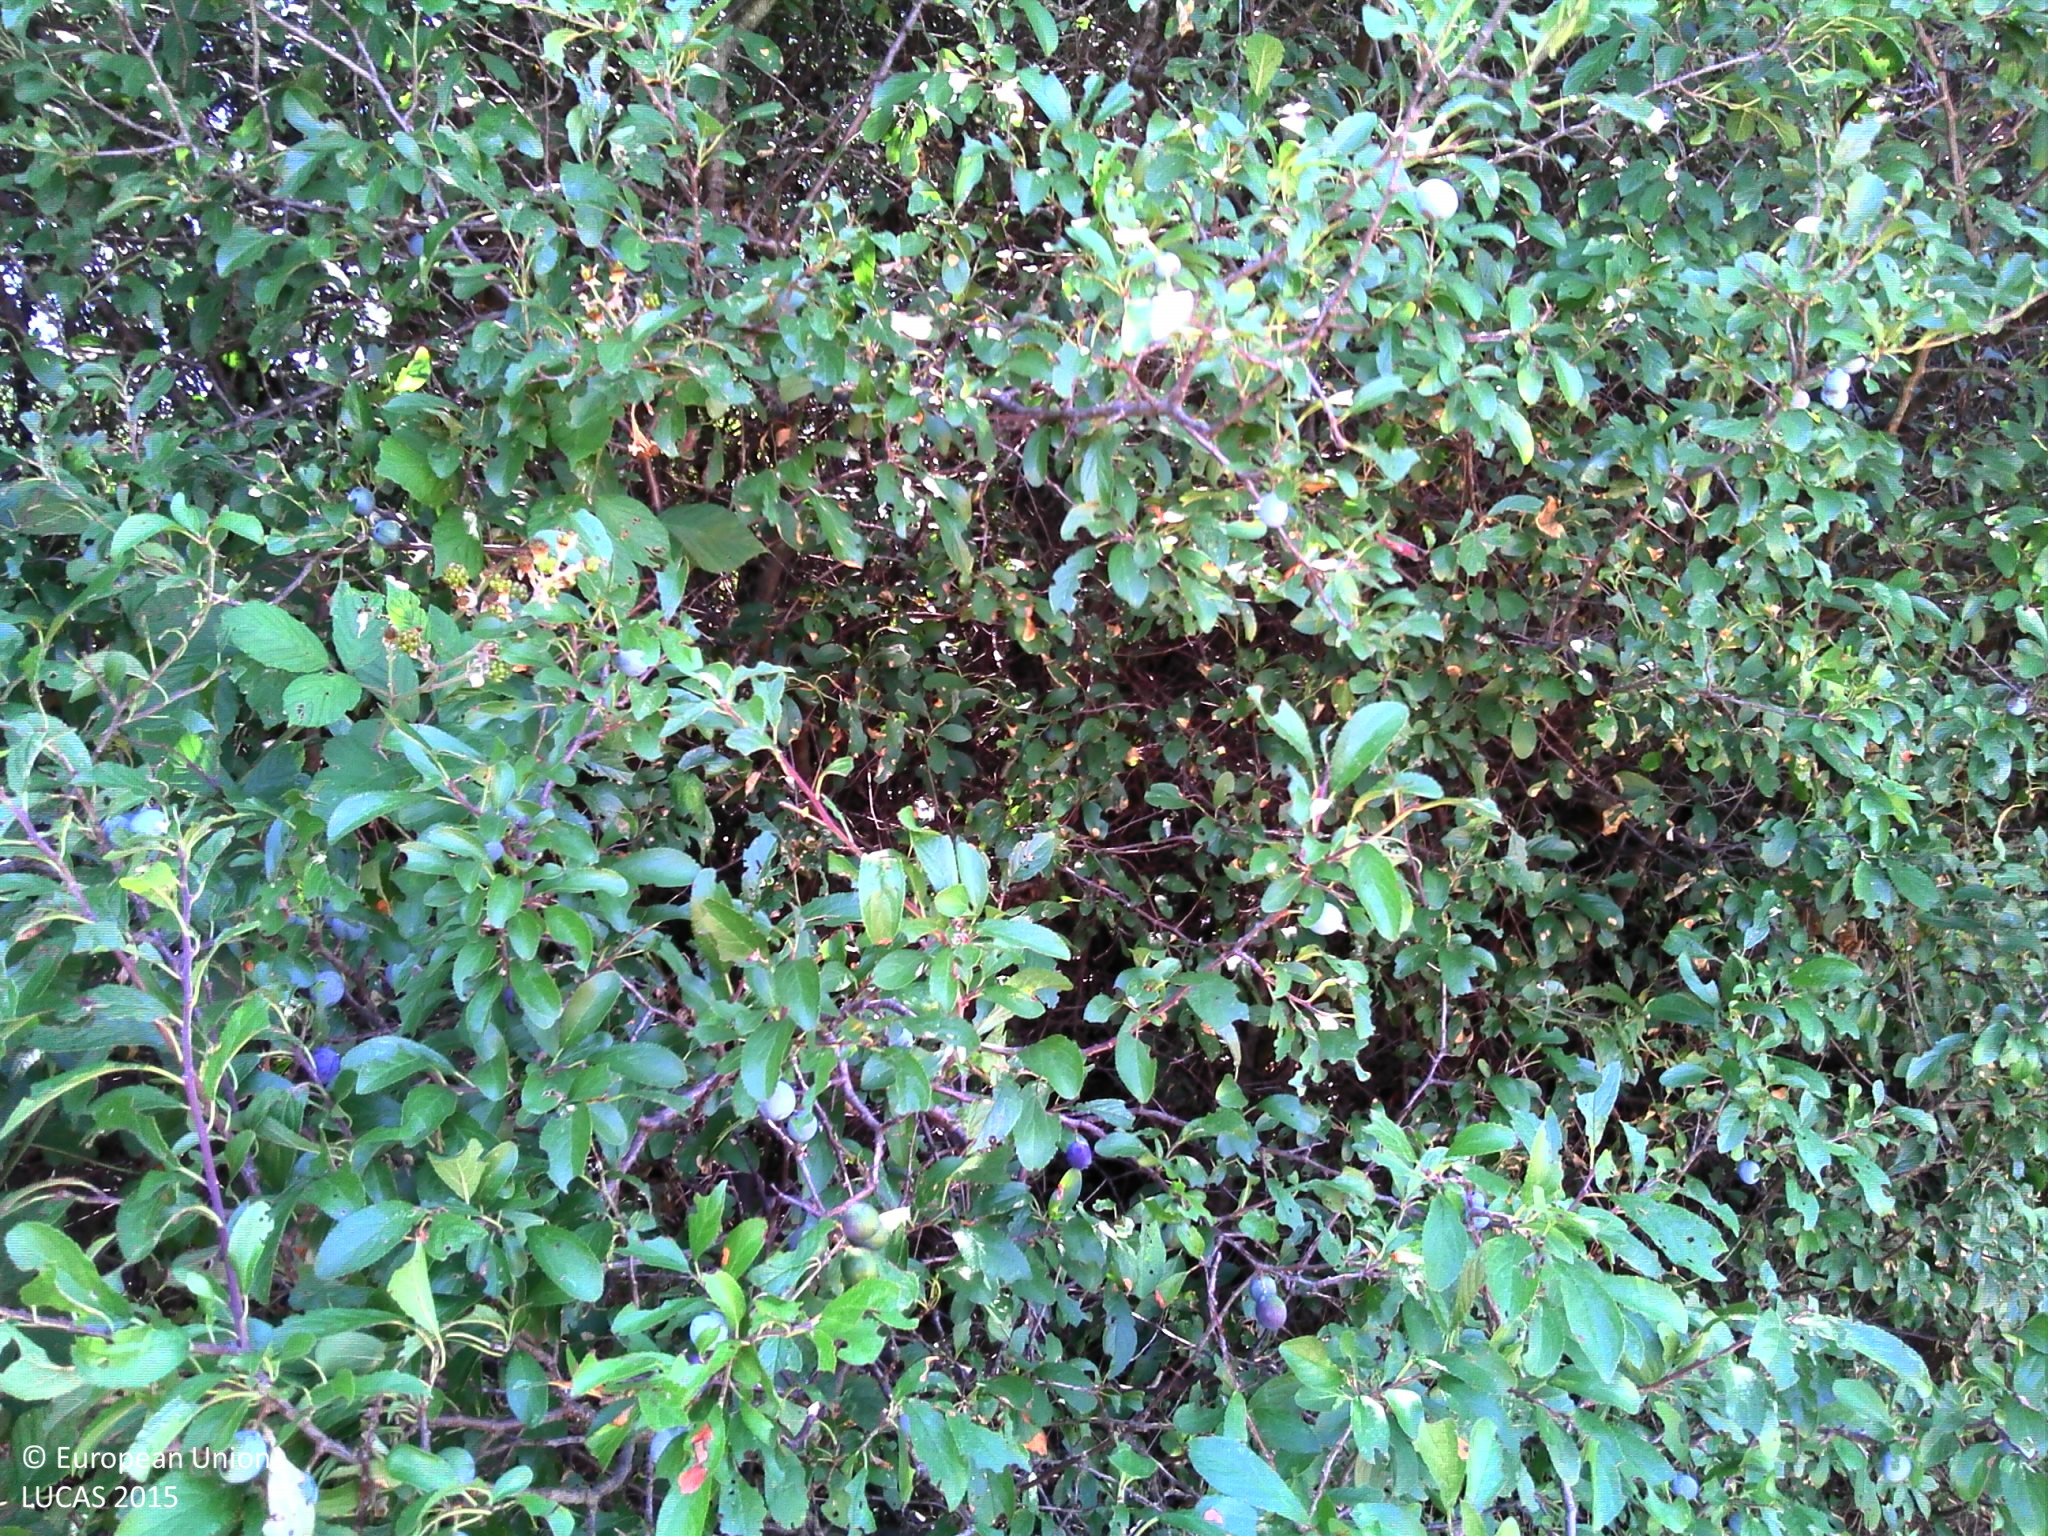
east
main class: Woodland
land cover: Broadleaved woodland
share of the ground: > 75 %
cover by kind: broadleaved forest trees 85 %, shrubs 5 %, herbaceous plants 5 %, lichens and mosses 5 %
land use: Semi-natural and natural areas not in use
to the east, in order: Broadleaved woodland; Grass margins; Paved roads, cycling and walking lanes; Ditches and canals; Electric lines; Broadleaved woodland; Fences; Grassland without tree/shrub cover; Ditches and canals; Lines of trees; Grassland without tree/shrub cover; Fences; Grassland without tree/shrub cover
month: July
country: FR
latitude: 45.5589
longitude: 4.1484
